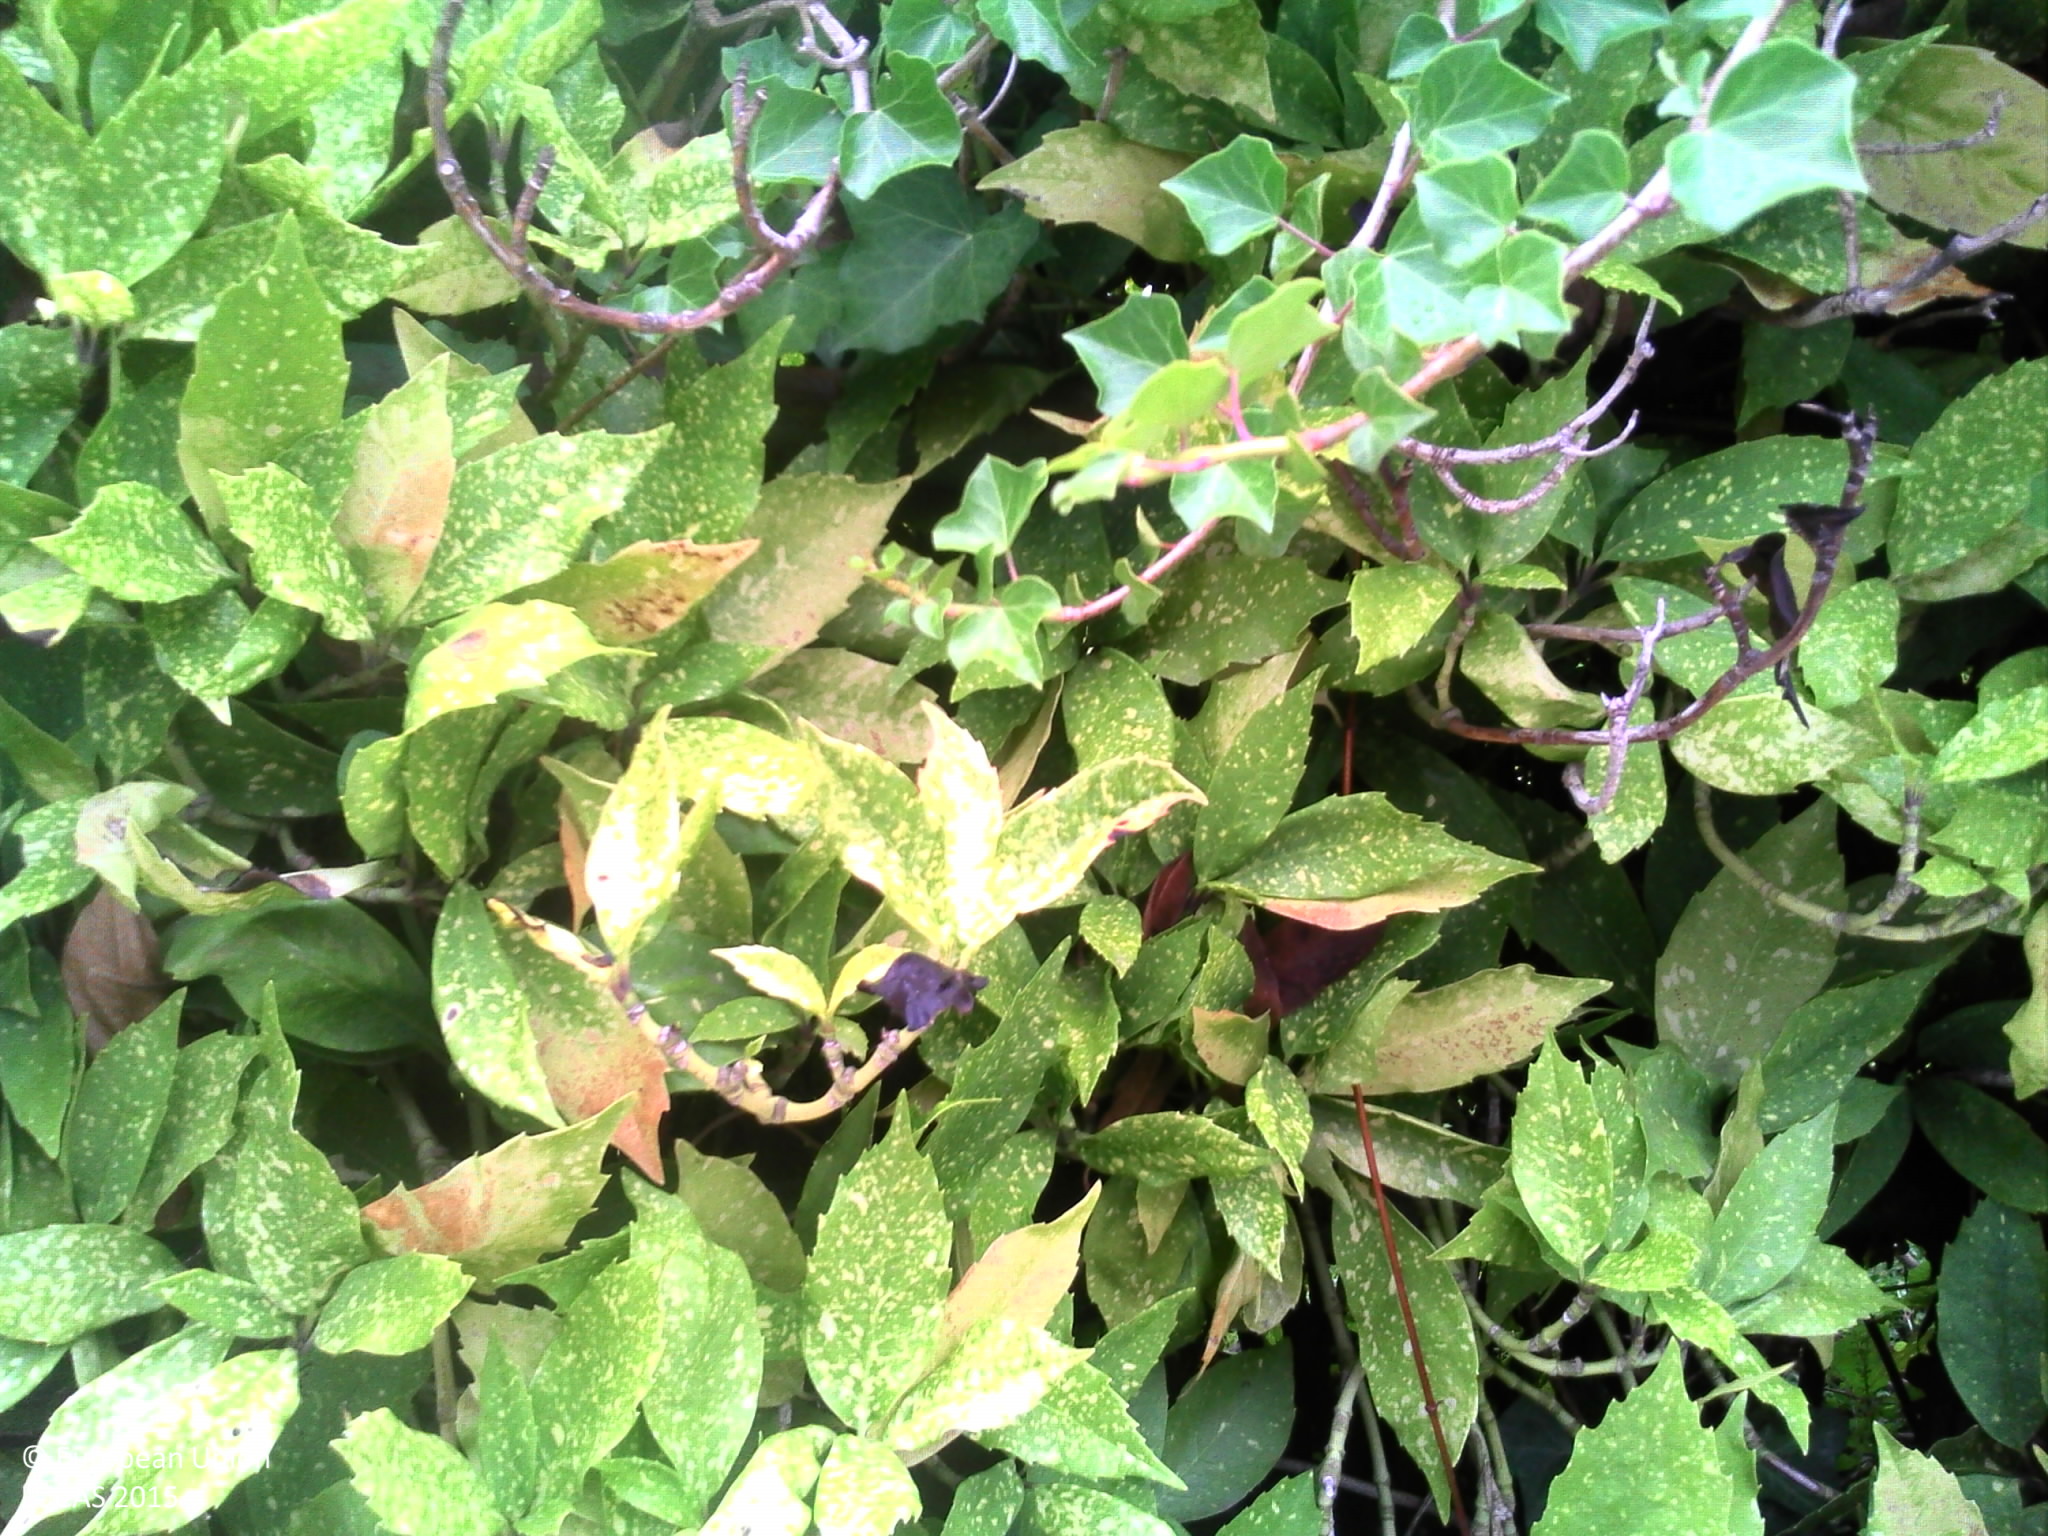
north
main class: Woodland
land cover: Broadleaved woodland
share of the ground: > 75 %
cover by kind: broadleaved forest trees 100 %
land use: Residential
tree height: > 5 m
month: July
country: FR
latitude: 47.9125
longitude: 1.9732
